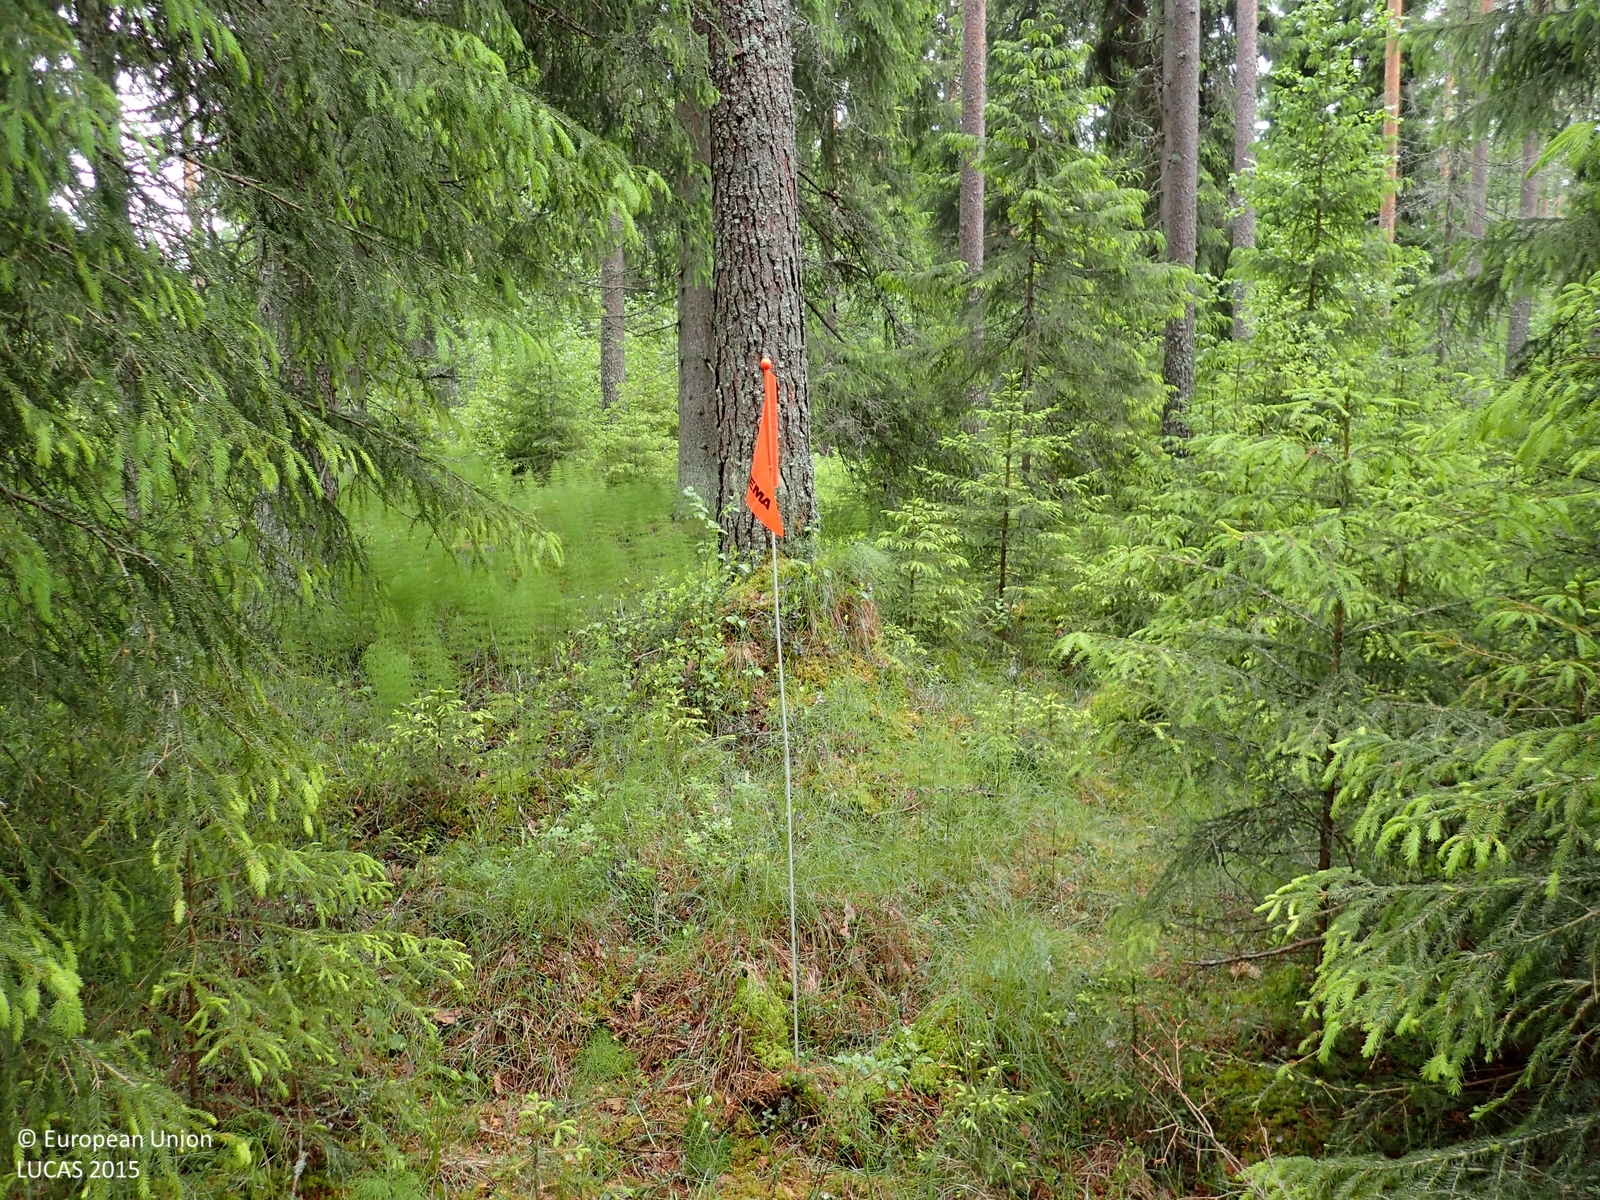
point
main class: Woodland
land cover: Other coniferous woodland
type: boreal forest
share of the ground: 50 - 75 %
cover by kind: coniferous forest trees 65 %, shrubs 15 %, herbaceous plants 15 %, broadleaved forest trees 5 %
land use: Forestry
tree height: > 5 m
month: June
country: FI
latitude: 62.3588
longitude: 21.6583
